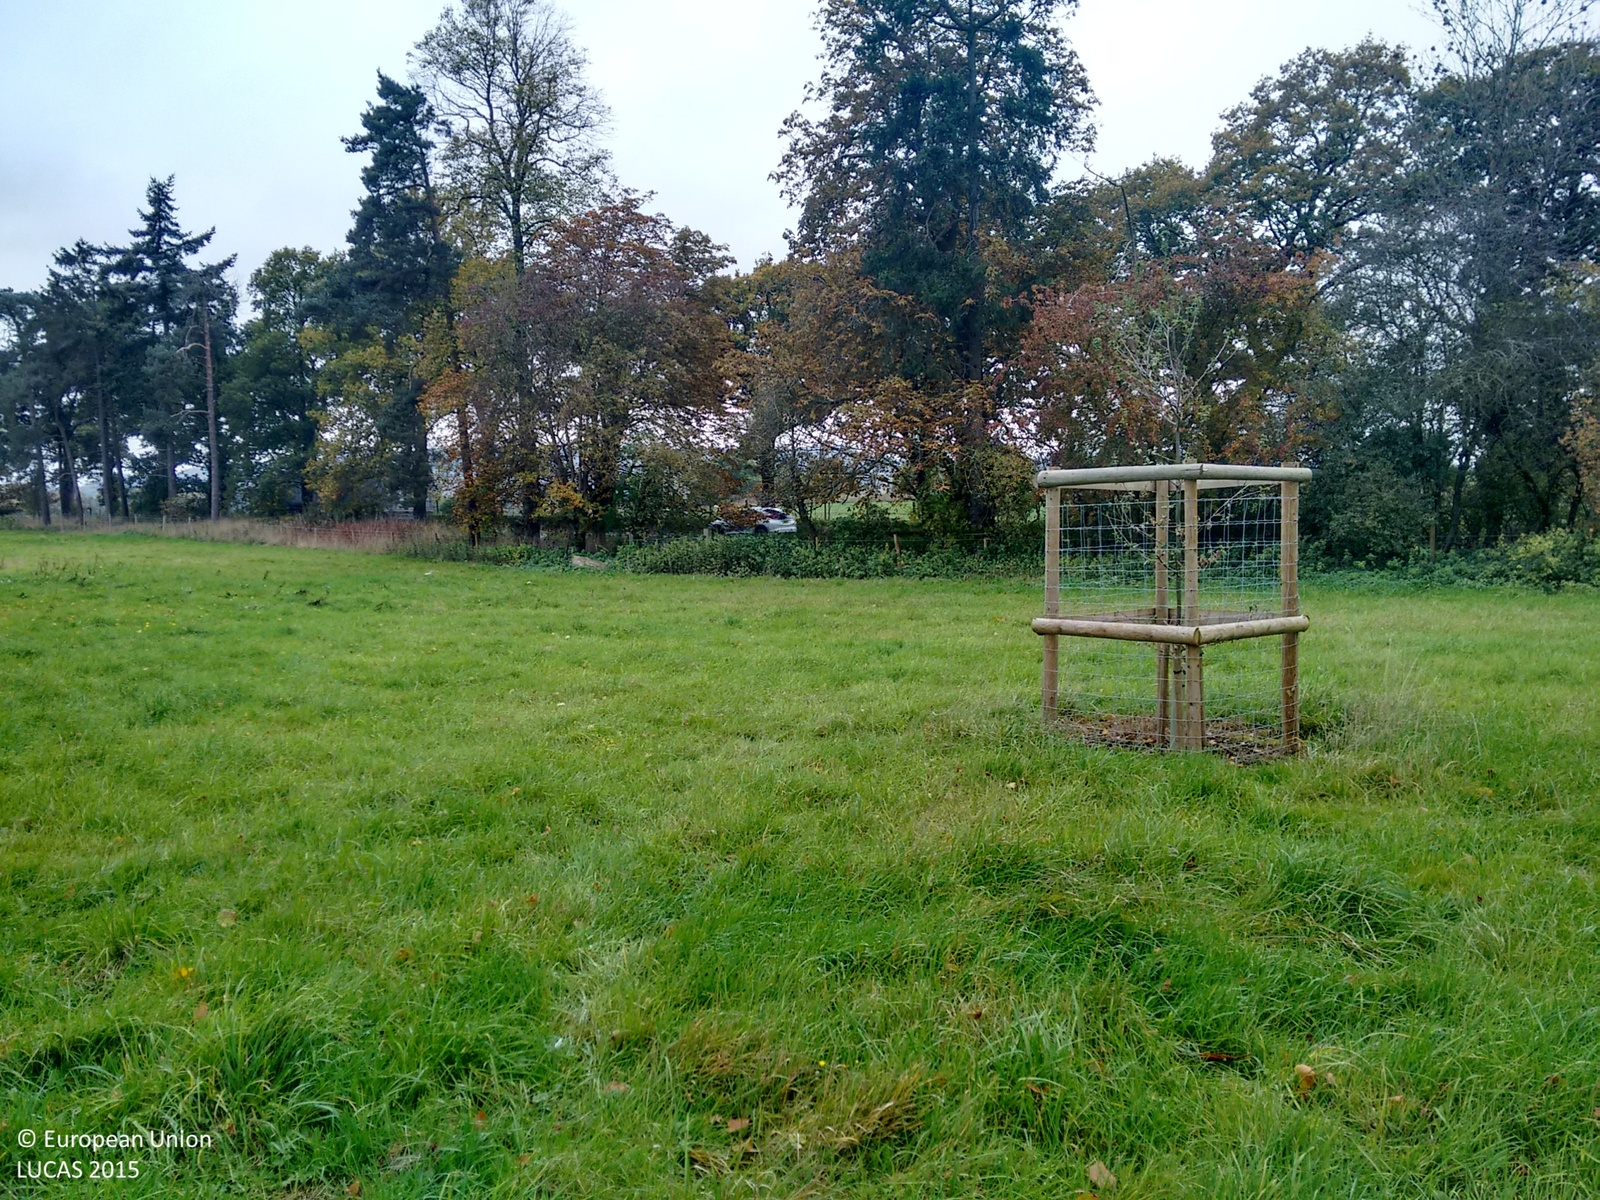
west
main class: Grassland
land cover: Grassland without tree/shrub cover
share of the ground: > 75 %
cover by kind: herbaceous plants 100 %
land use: Agriculture (excluding fallow land and kitchen gardens)
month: October
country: GB
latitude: 52.4606
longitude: -2.8322
